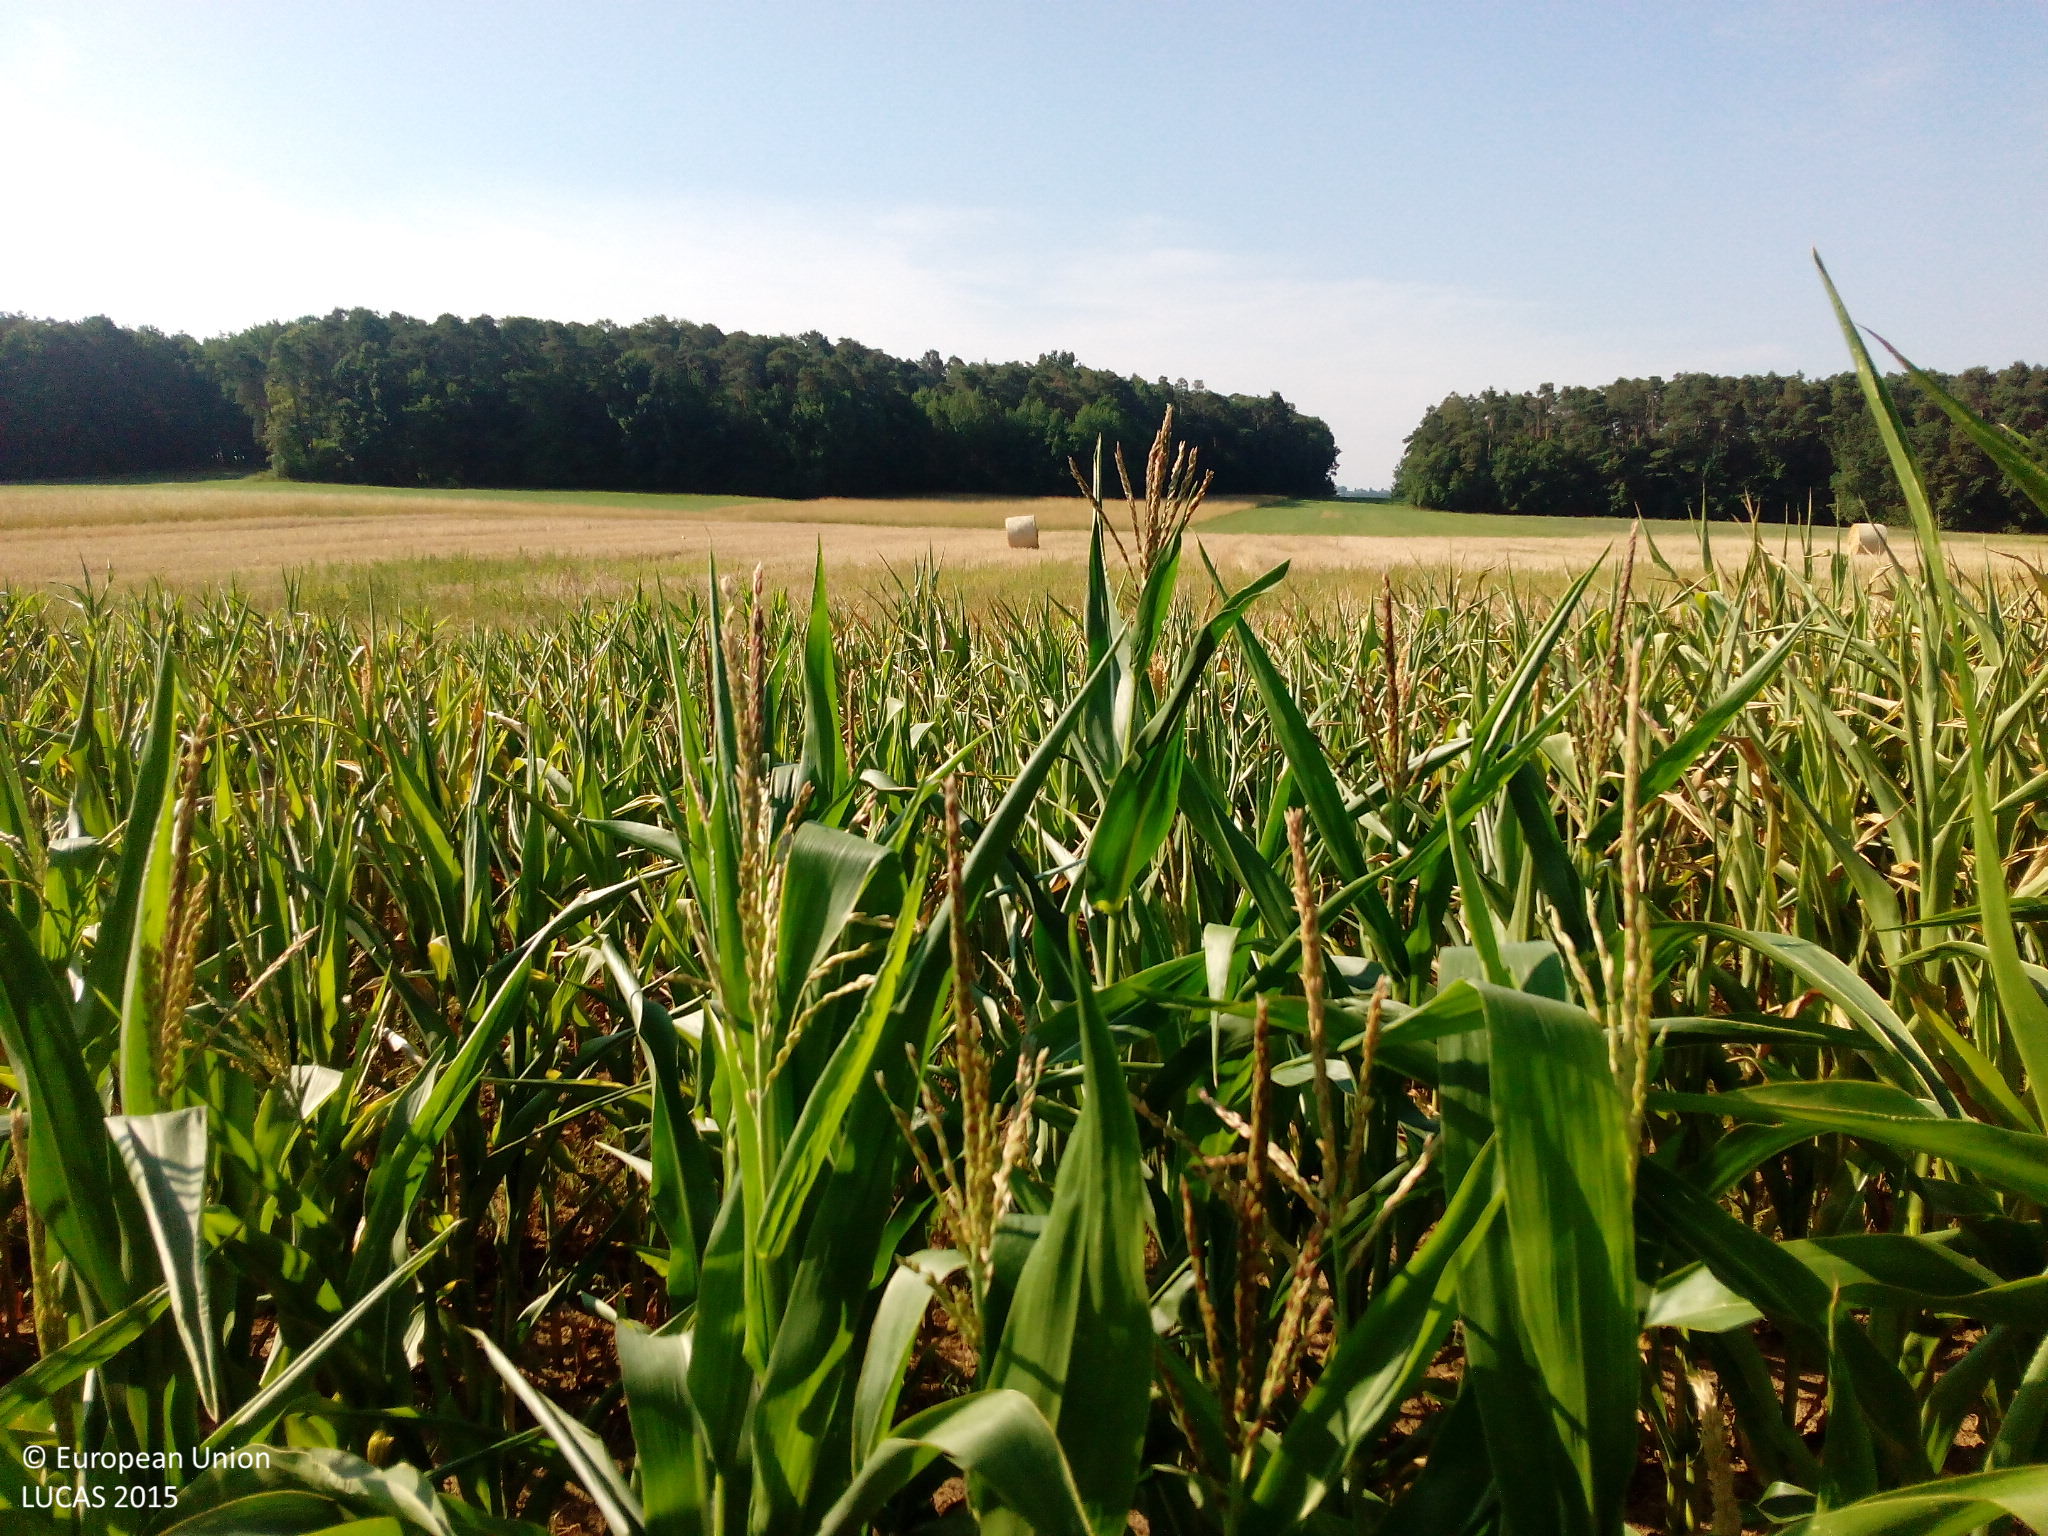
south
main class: Cropland
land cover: Maize
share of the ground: > 75 %
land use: Agriculture (excluding fallow land and kitchen gardens)
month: July
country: DE
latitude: 49.6577
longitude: 11.0663
